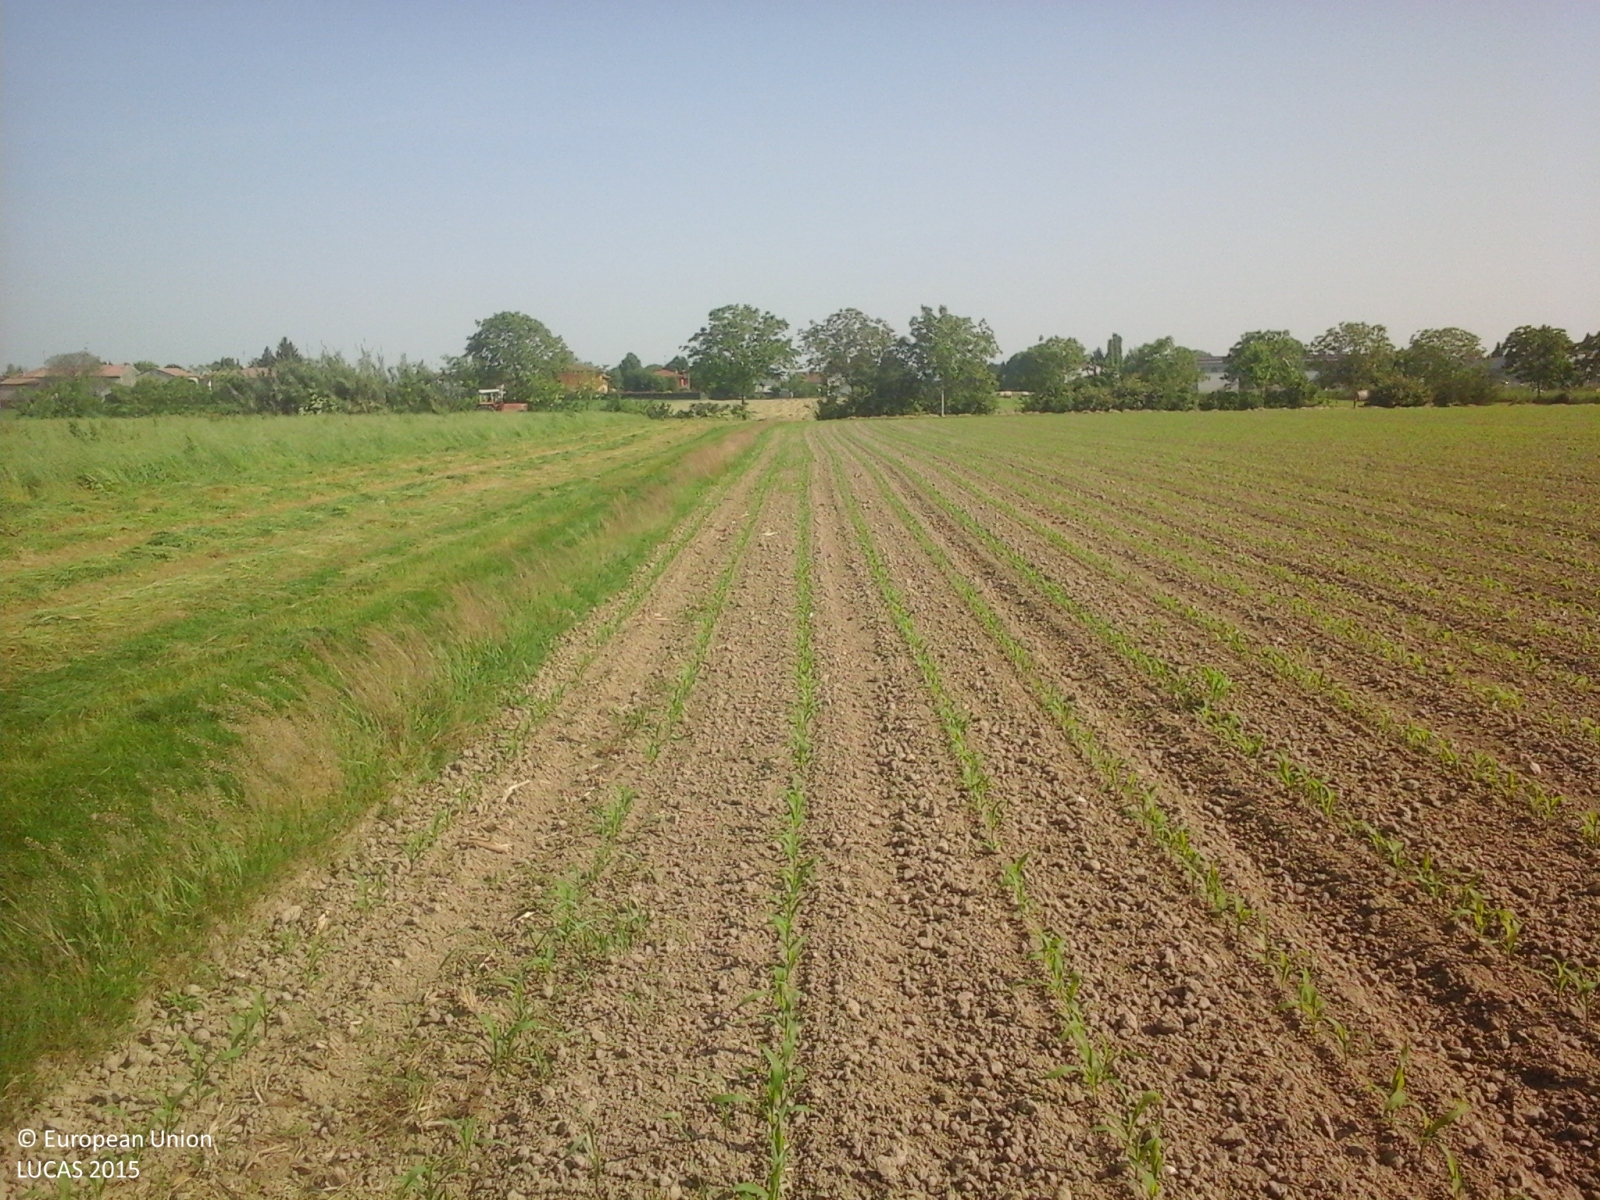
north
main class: Cropland
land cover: Maize
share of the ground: < 10 %
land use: Agriculture (excluding fallow land and kitchen gardens)
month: May
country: IT
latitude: 45.0497
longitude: 10.9251
